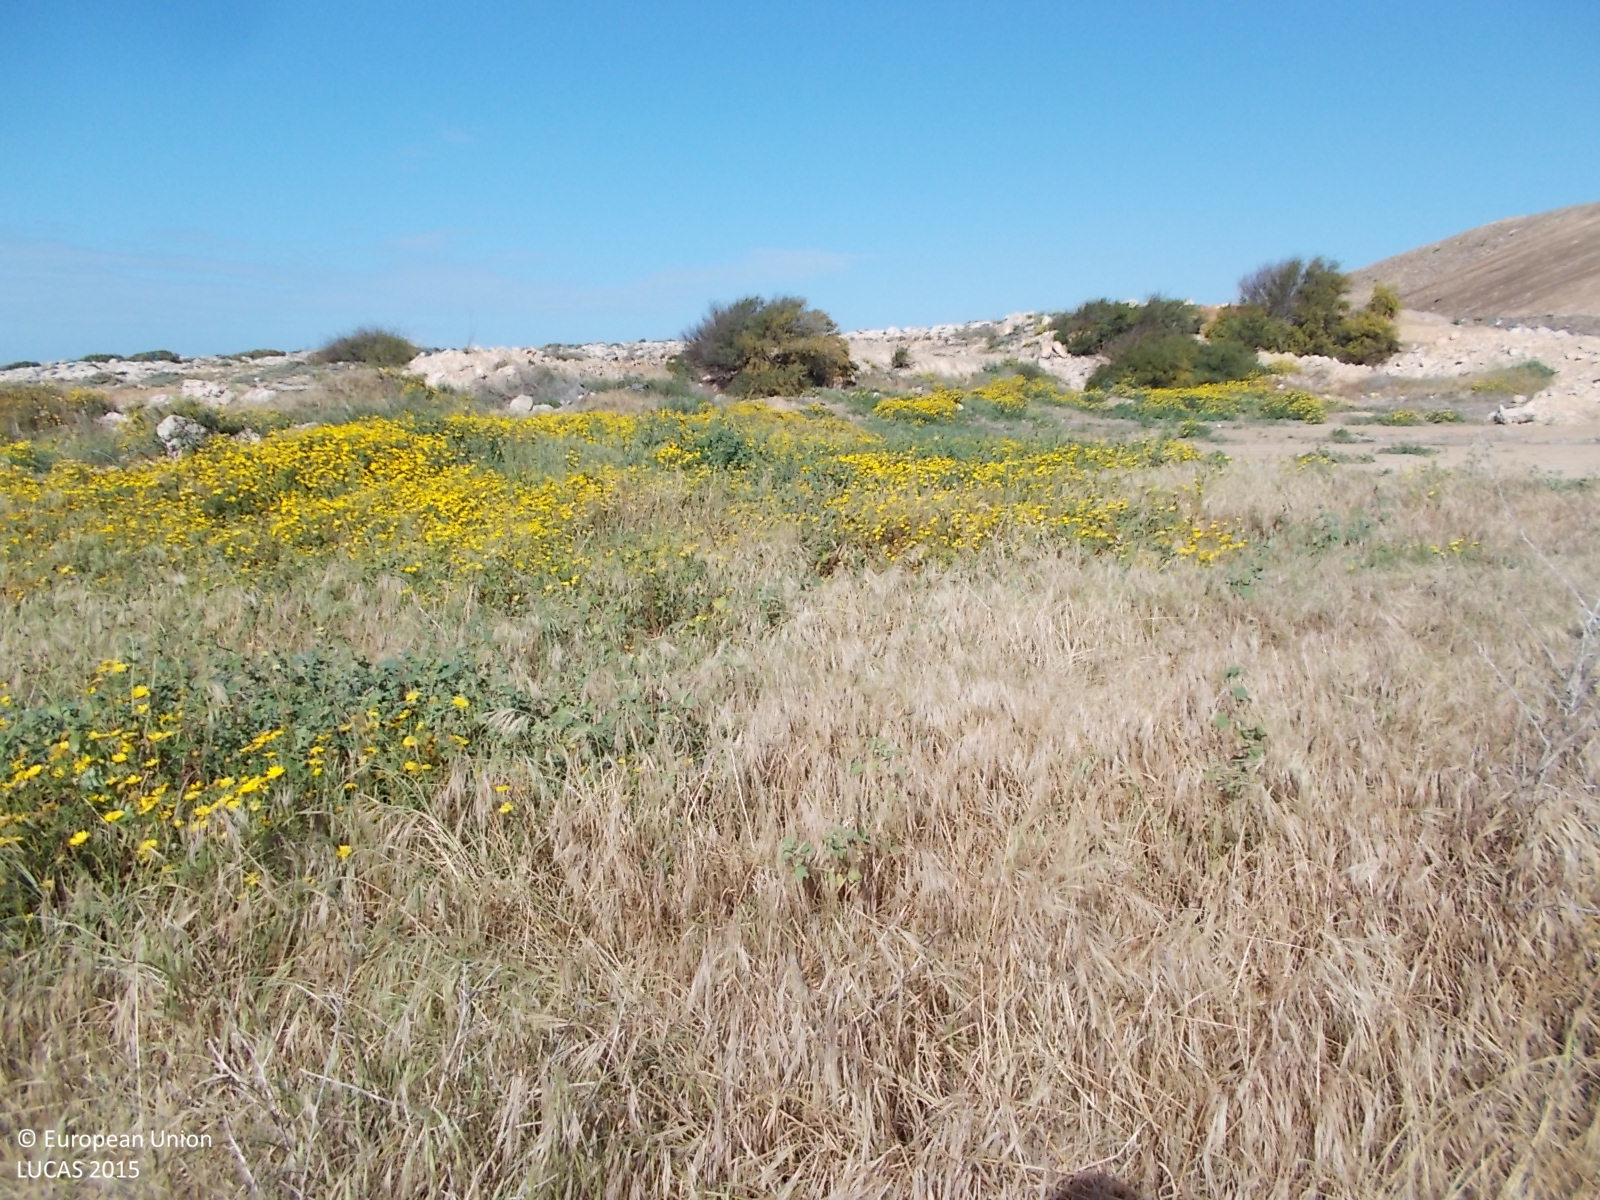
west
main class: Grassland
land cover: Grassland without tree/shrub cover
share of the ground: > 75 %
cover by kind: herbaceous plants 100 %
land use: Semi-natural and natural areas not in use
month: March
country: CY
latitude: 34.9673
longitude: 34.0600
